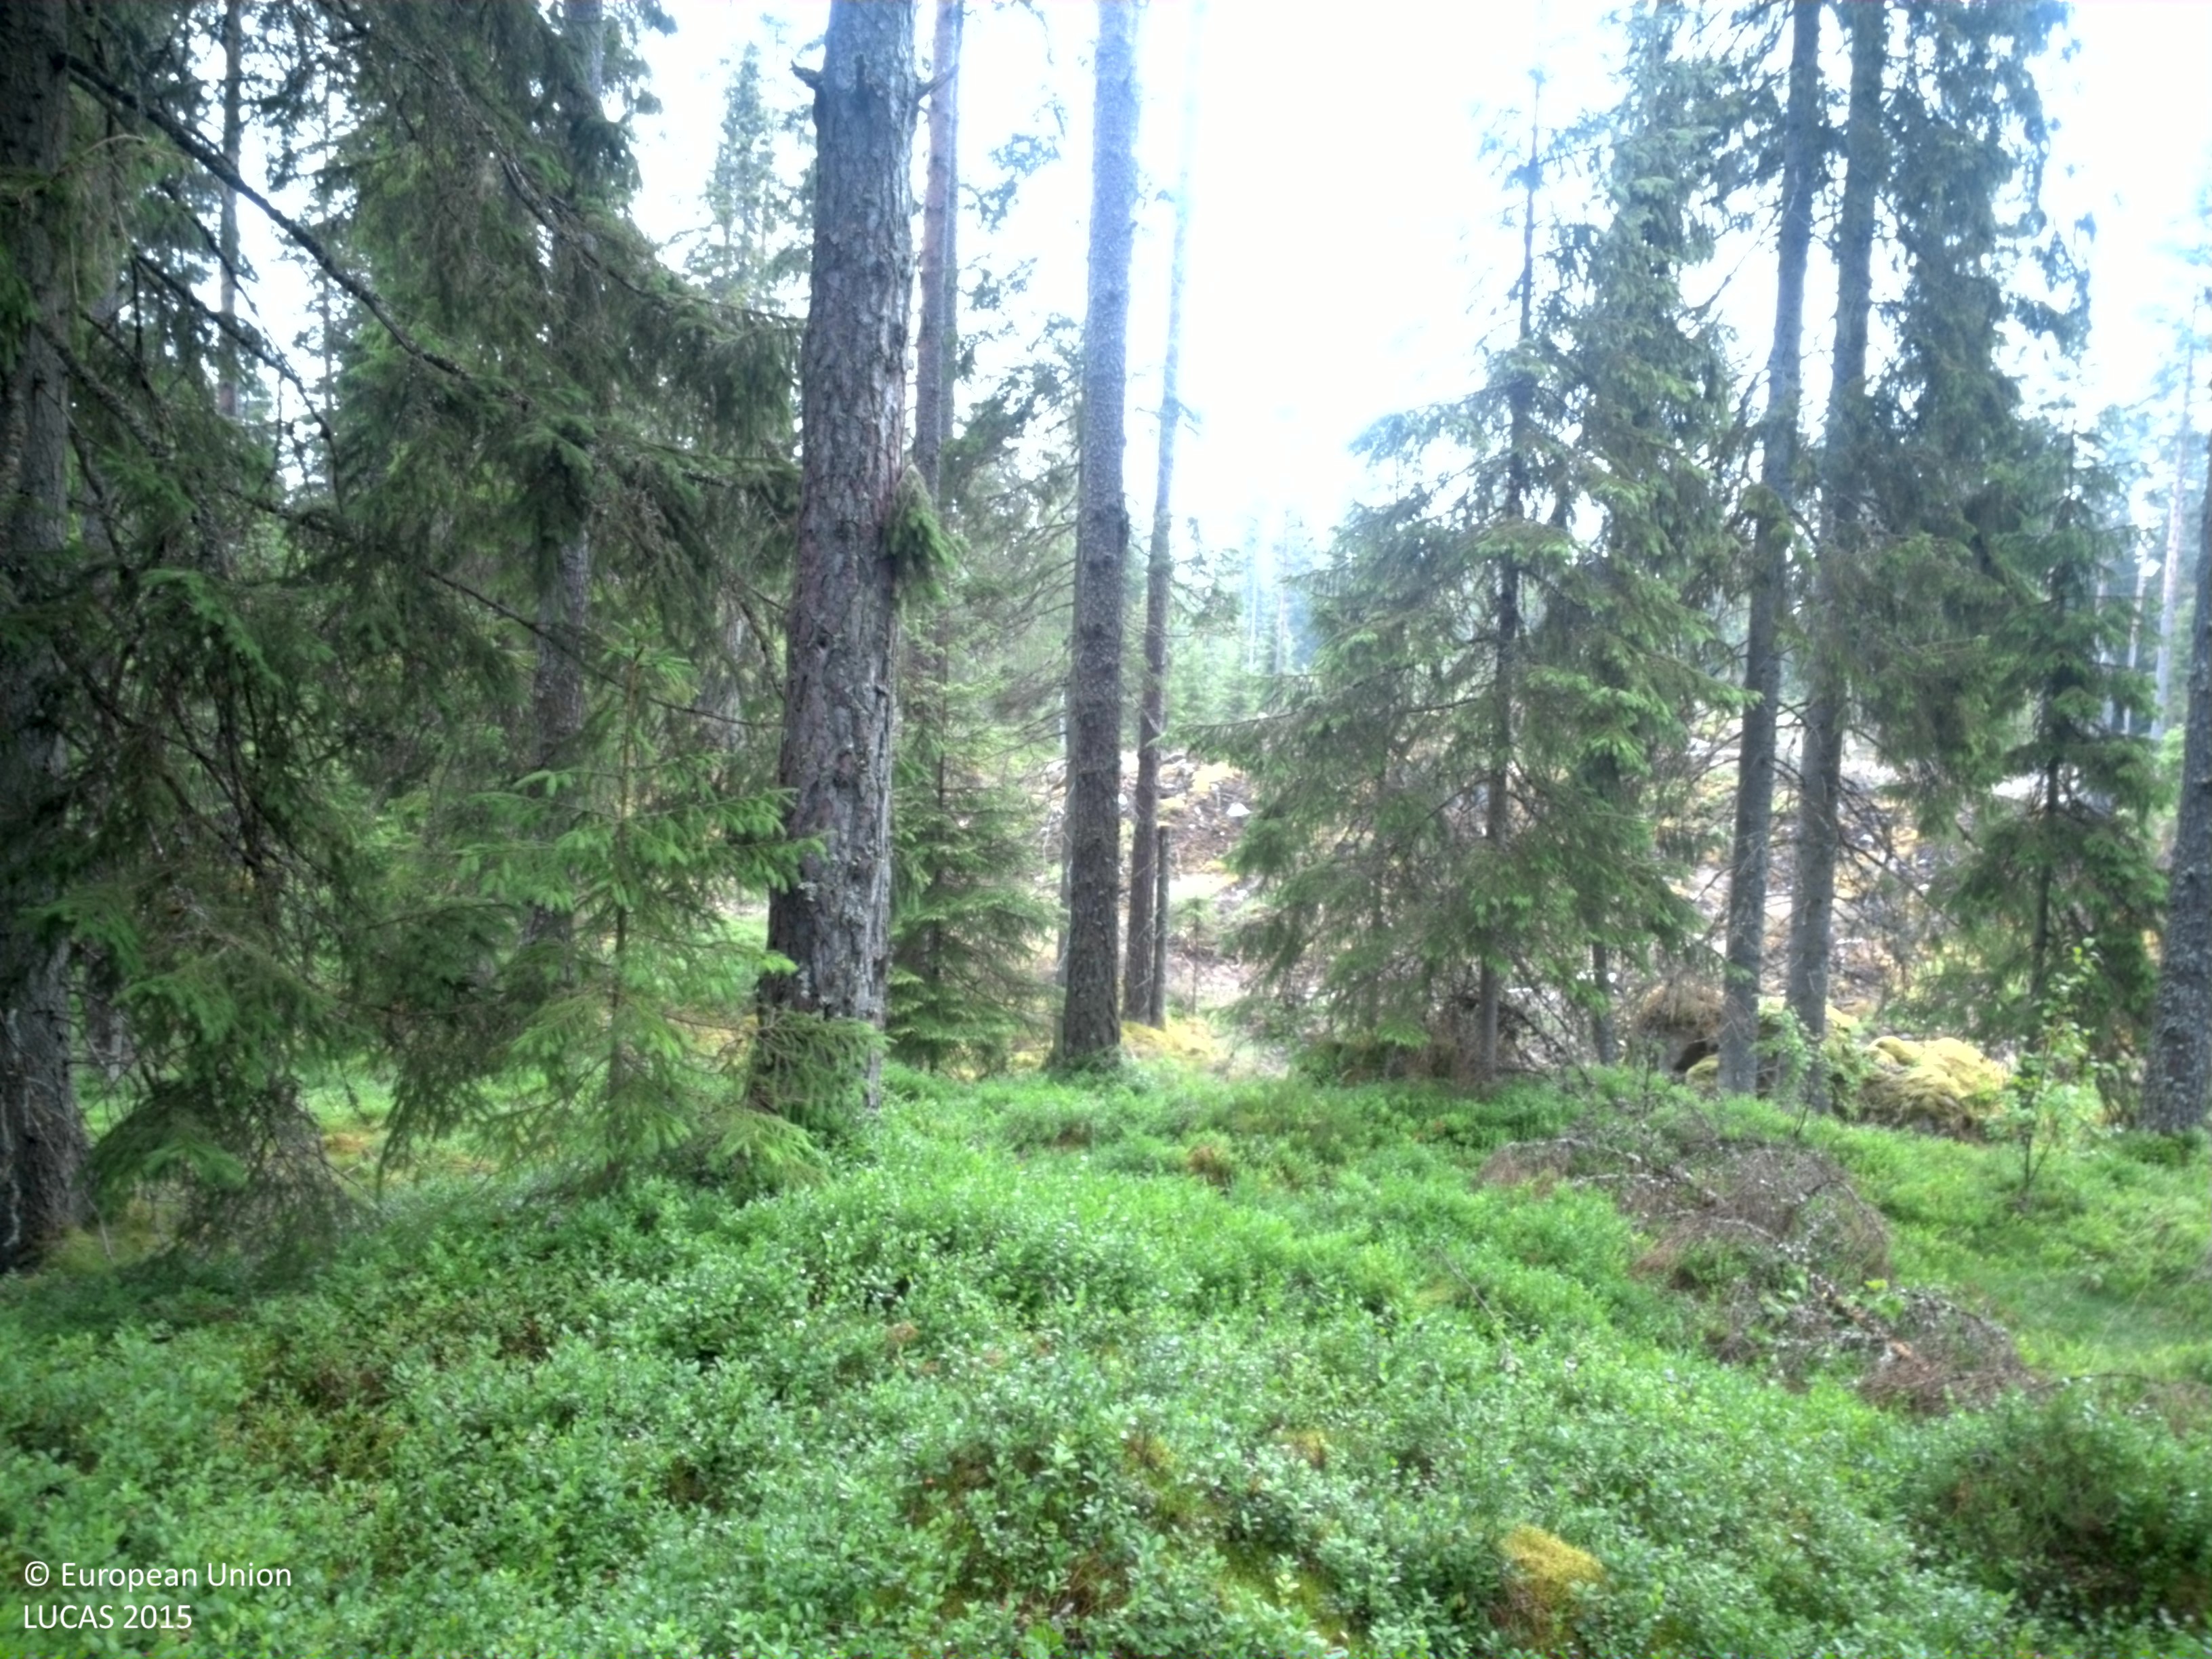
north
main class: Woodland
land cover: Spruce dominated coniferous woodland
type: boreal forest
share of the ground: 50 - 75 %
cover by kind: coniferous forest trees 75 %, shrubs 20 %, lichens and mosses 5 %
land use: Forestry
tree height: > 5 m
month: July
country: SE
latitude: 57.5882
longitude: 14.4283
